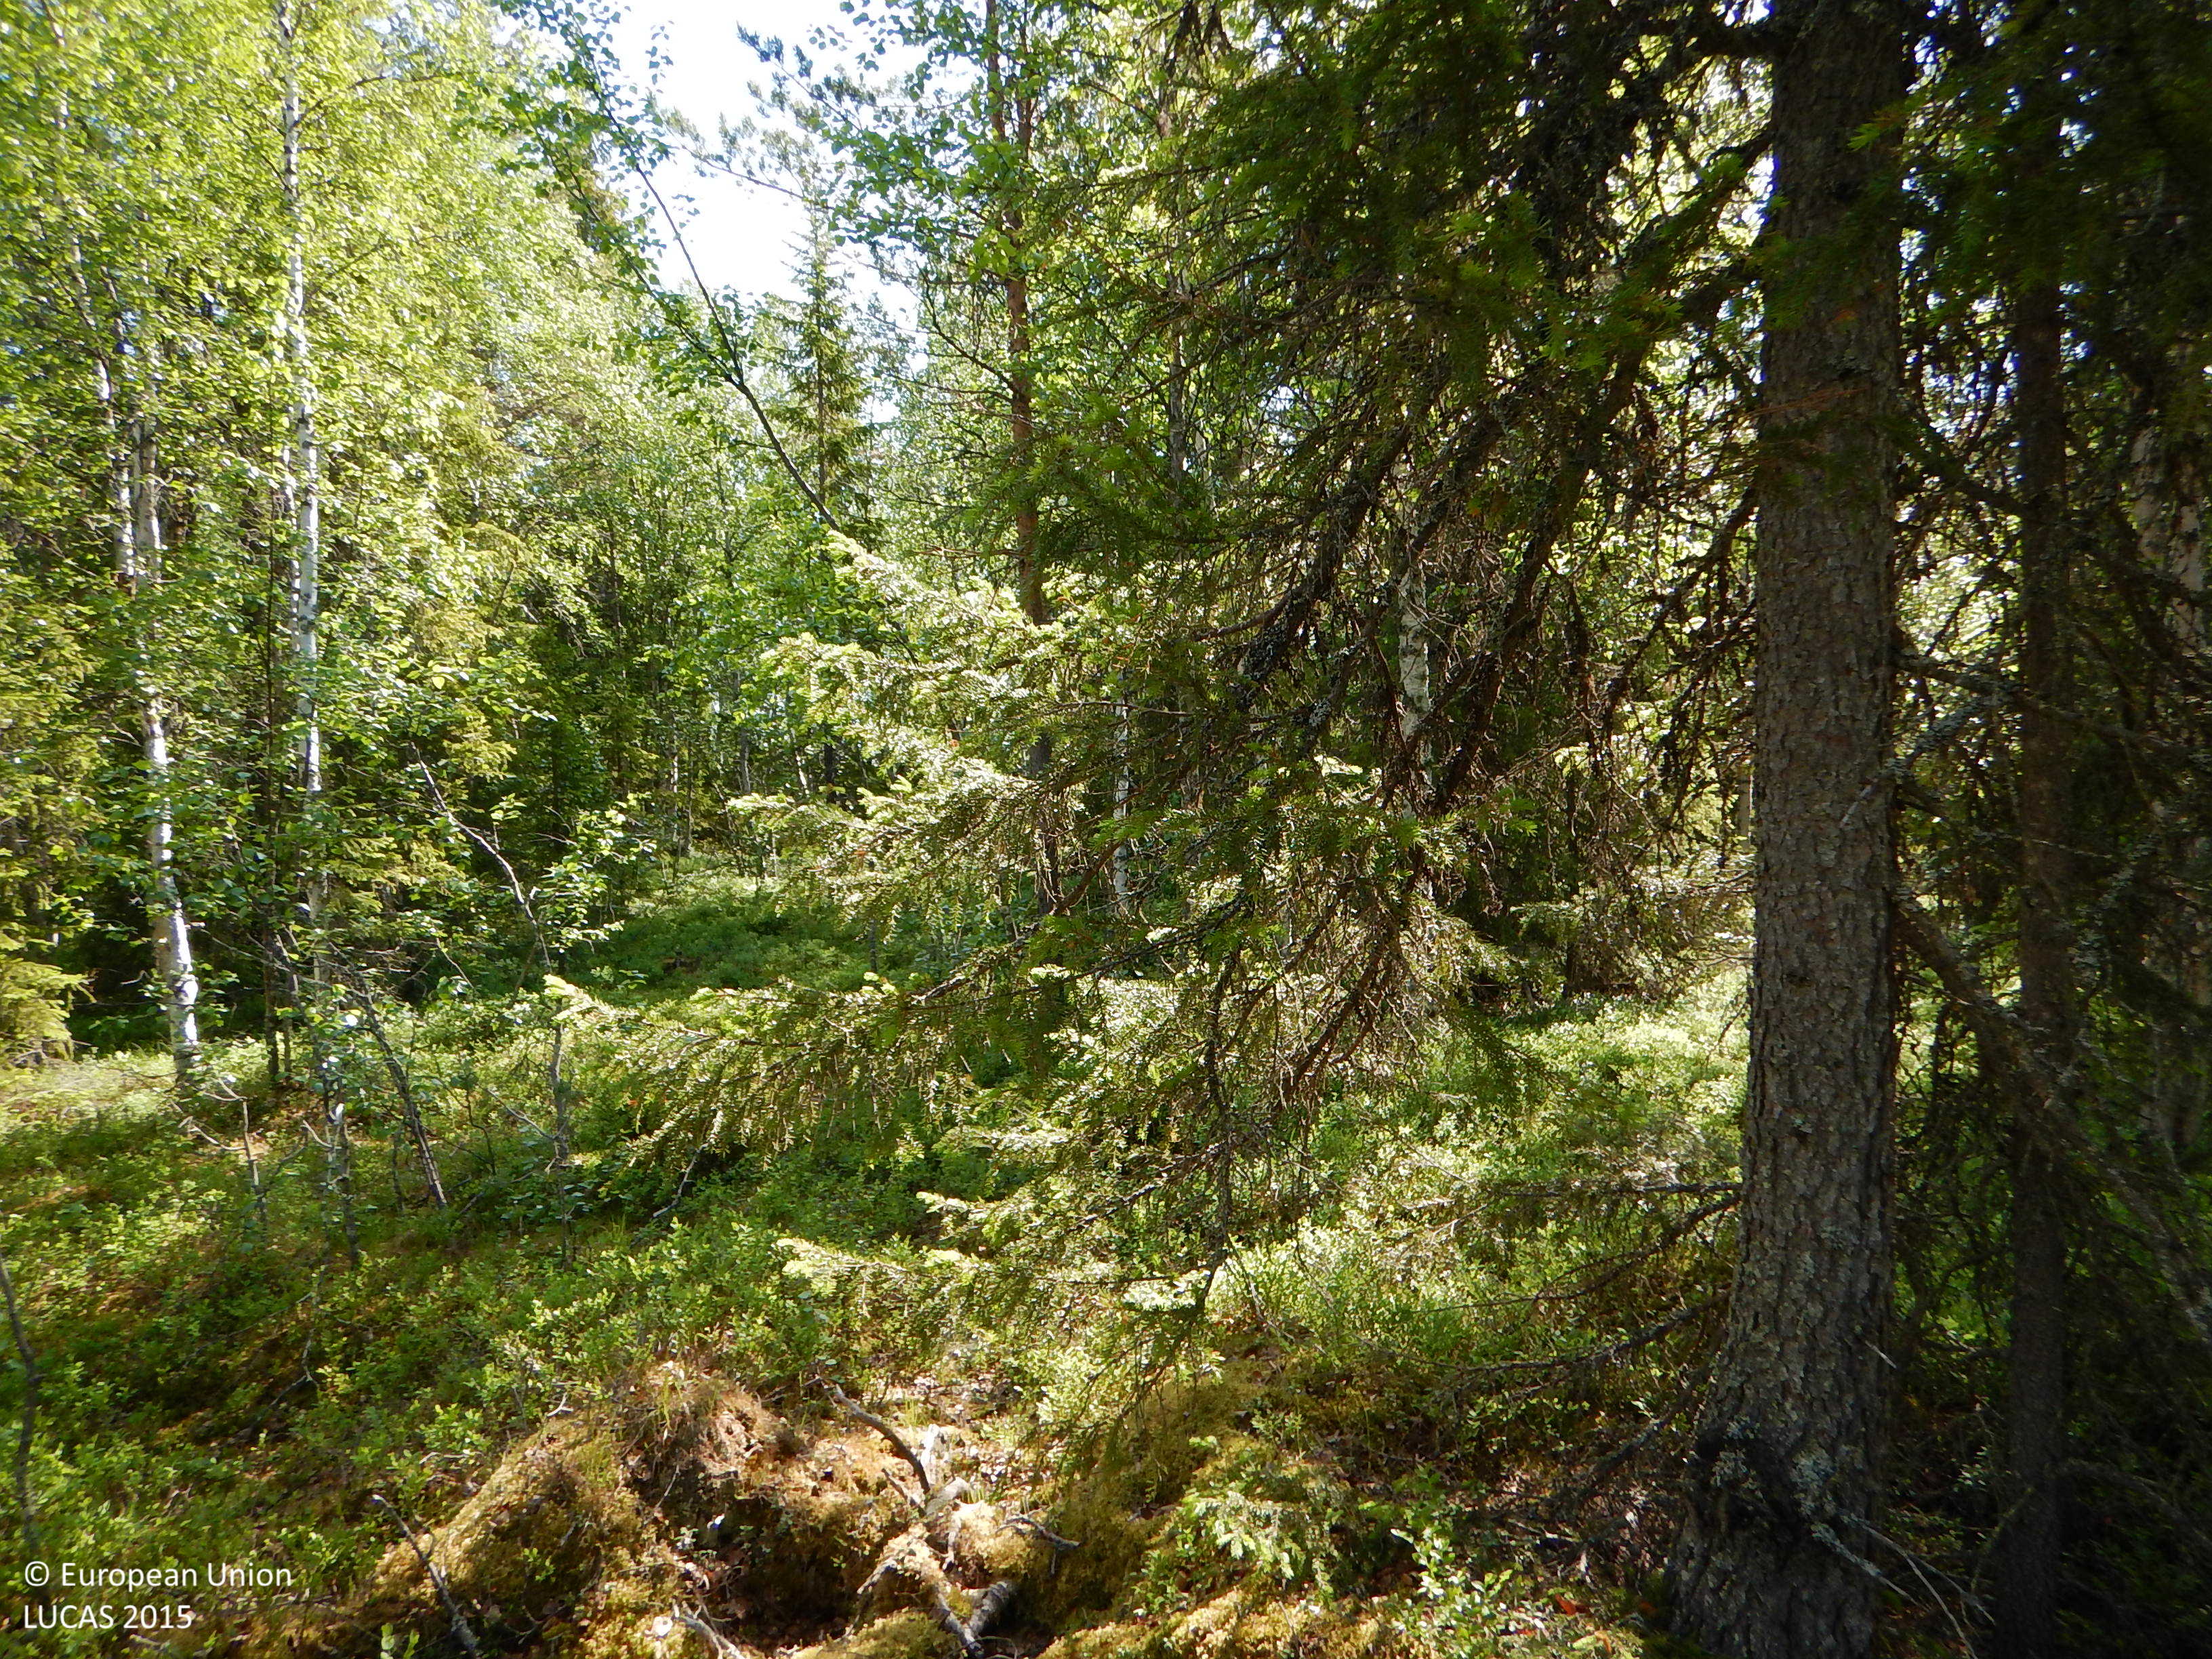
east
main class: Woodland
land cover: Spruce dominated mixed woodland
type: boreal forest
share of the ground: 25 - 50 %
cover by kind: shrubs 30 %, lichens and mosses 25 %, coniferous forest trees 20 %, broadleaved forest trees 15 %, herbaceous plants 10 %
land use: Forestry
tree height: > 5 m
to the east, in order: Spruce dominated mixed woodland; Pine dominated coniferous woodland; Ditches and canals; Pine dominated mixed woodland; Pine dominated coniferous woodland; Peatbogs
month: July
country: SE
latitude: 65.0954
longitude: 18.5404
